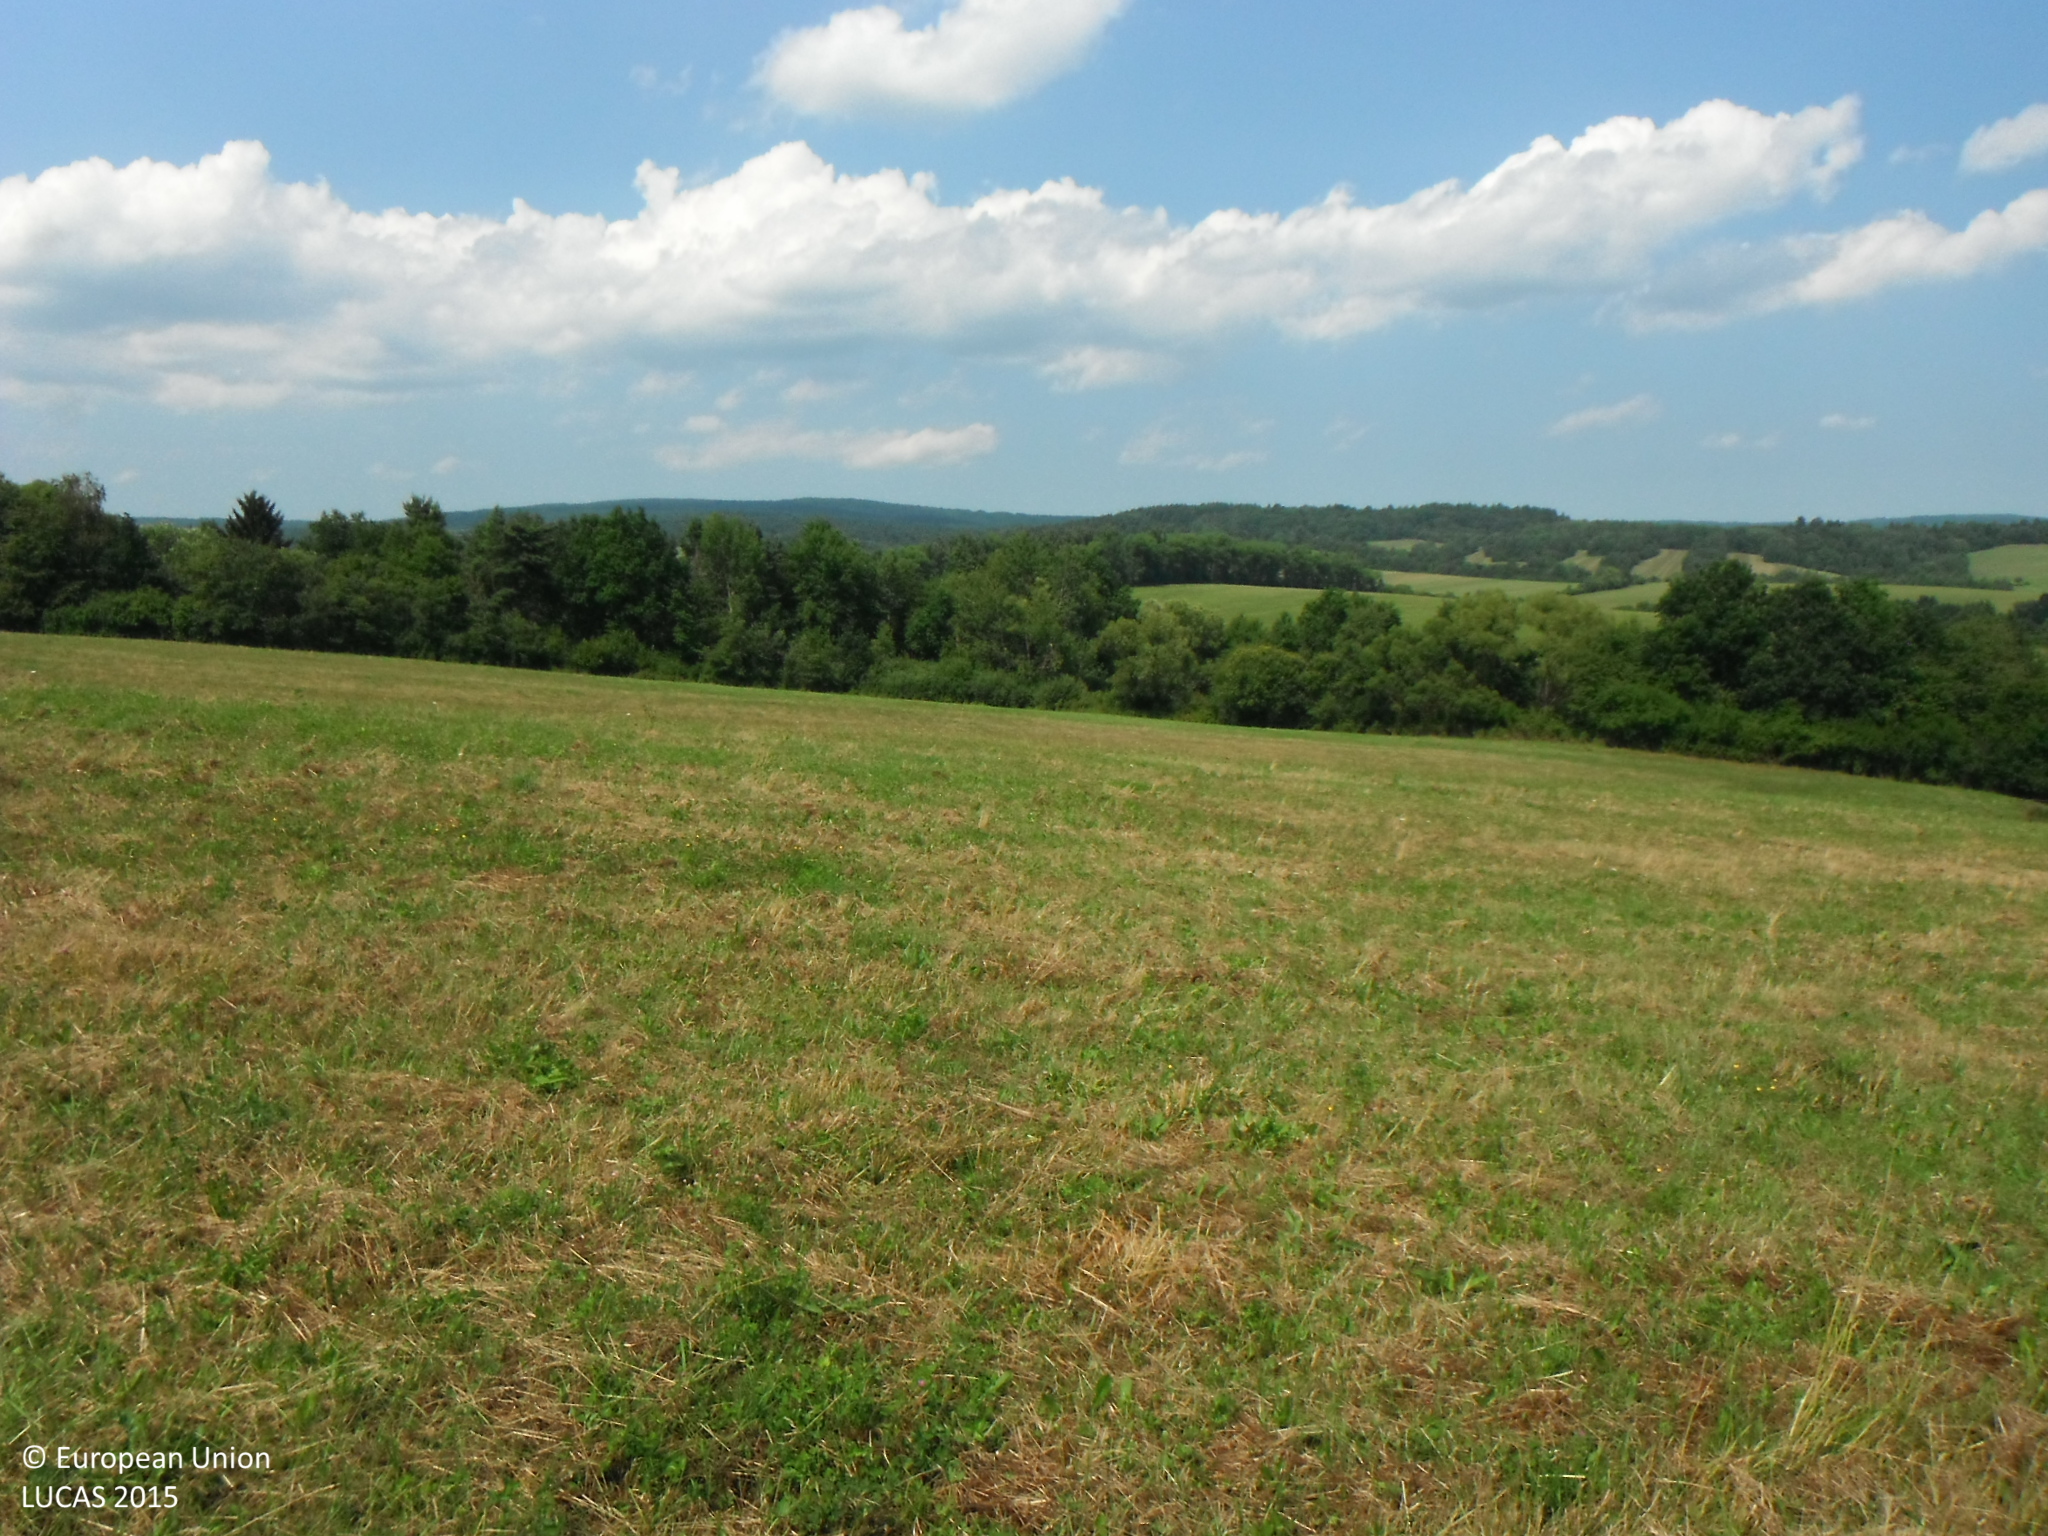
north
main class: Grassland
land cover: Grassland without tree/shrub cover
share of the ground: > 75 %
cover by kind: herbaceous plants 100 %
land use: Agriculture (excluding fallow land and kitchen gardens)
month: July
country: SK
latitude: 49.3676
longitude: 21.4647
